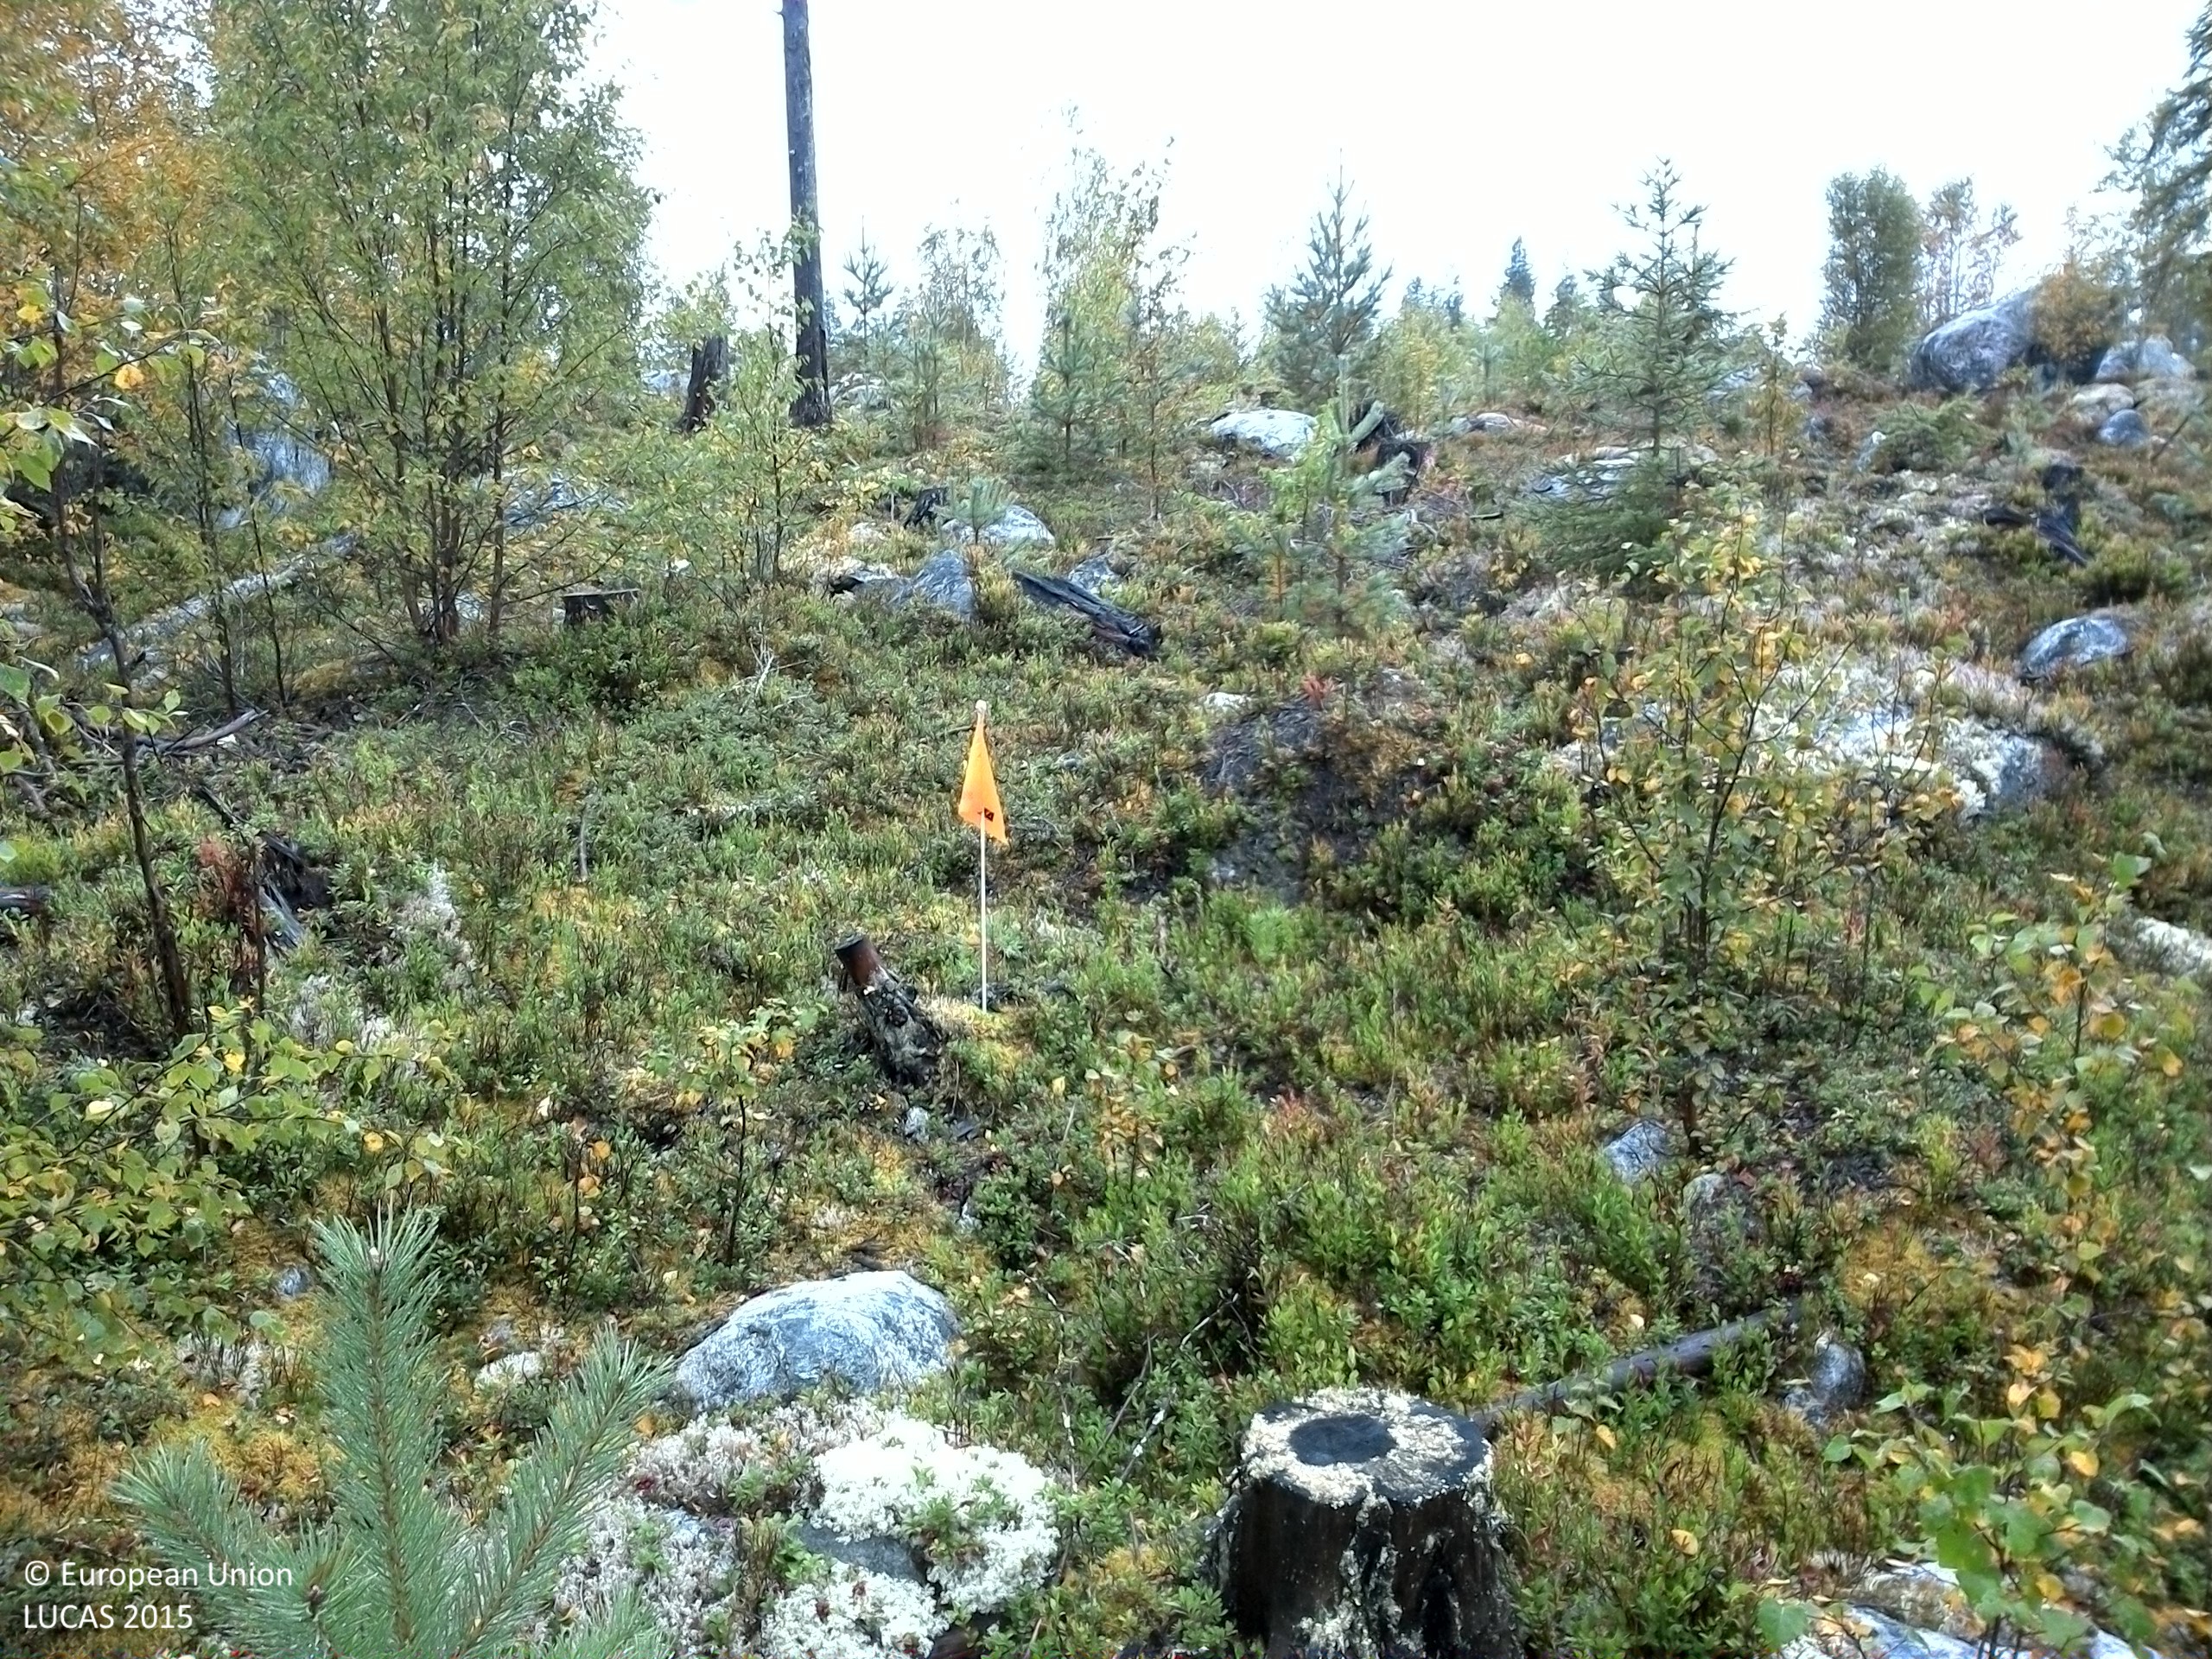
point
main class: Woodland
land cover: Other mixed woodland
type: boreal forest
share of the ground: 10 - 25 %
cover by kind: shrubs 35 %, lichens and mosses 20 %, broadleaved forest trees 15 %, consolidated bare surface 15 %, coniferous forest trees 10 %, herbaceous plants 5 %
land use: Forestry
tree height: > 5 m
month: September
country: SE
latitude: 61.4959
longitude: 15.1124
